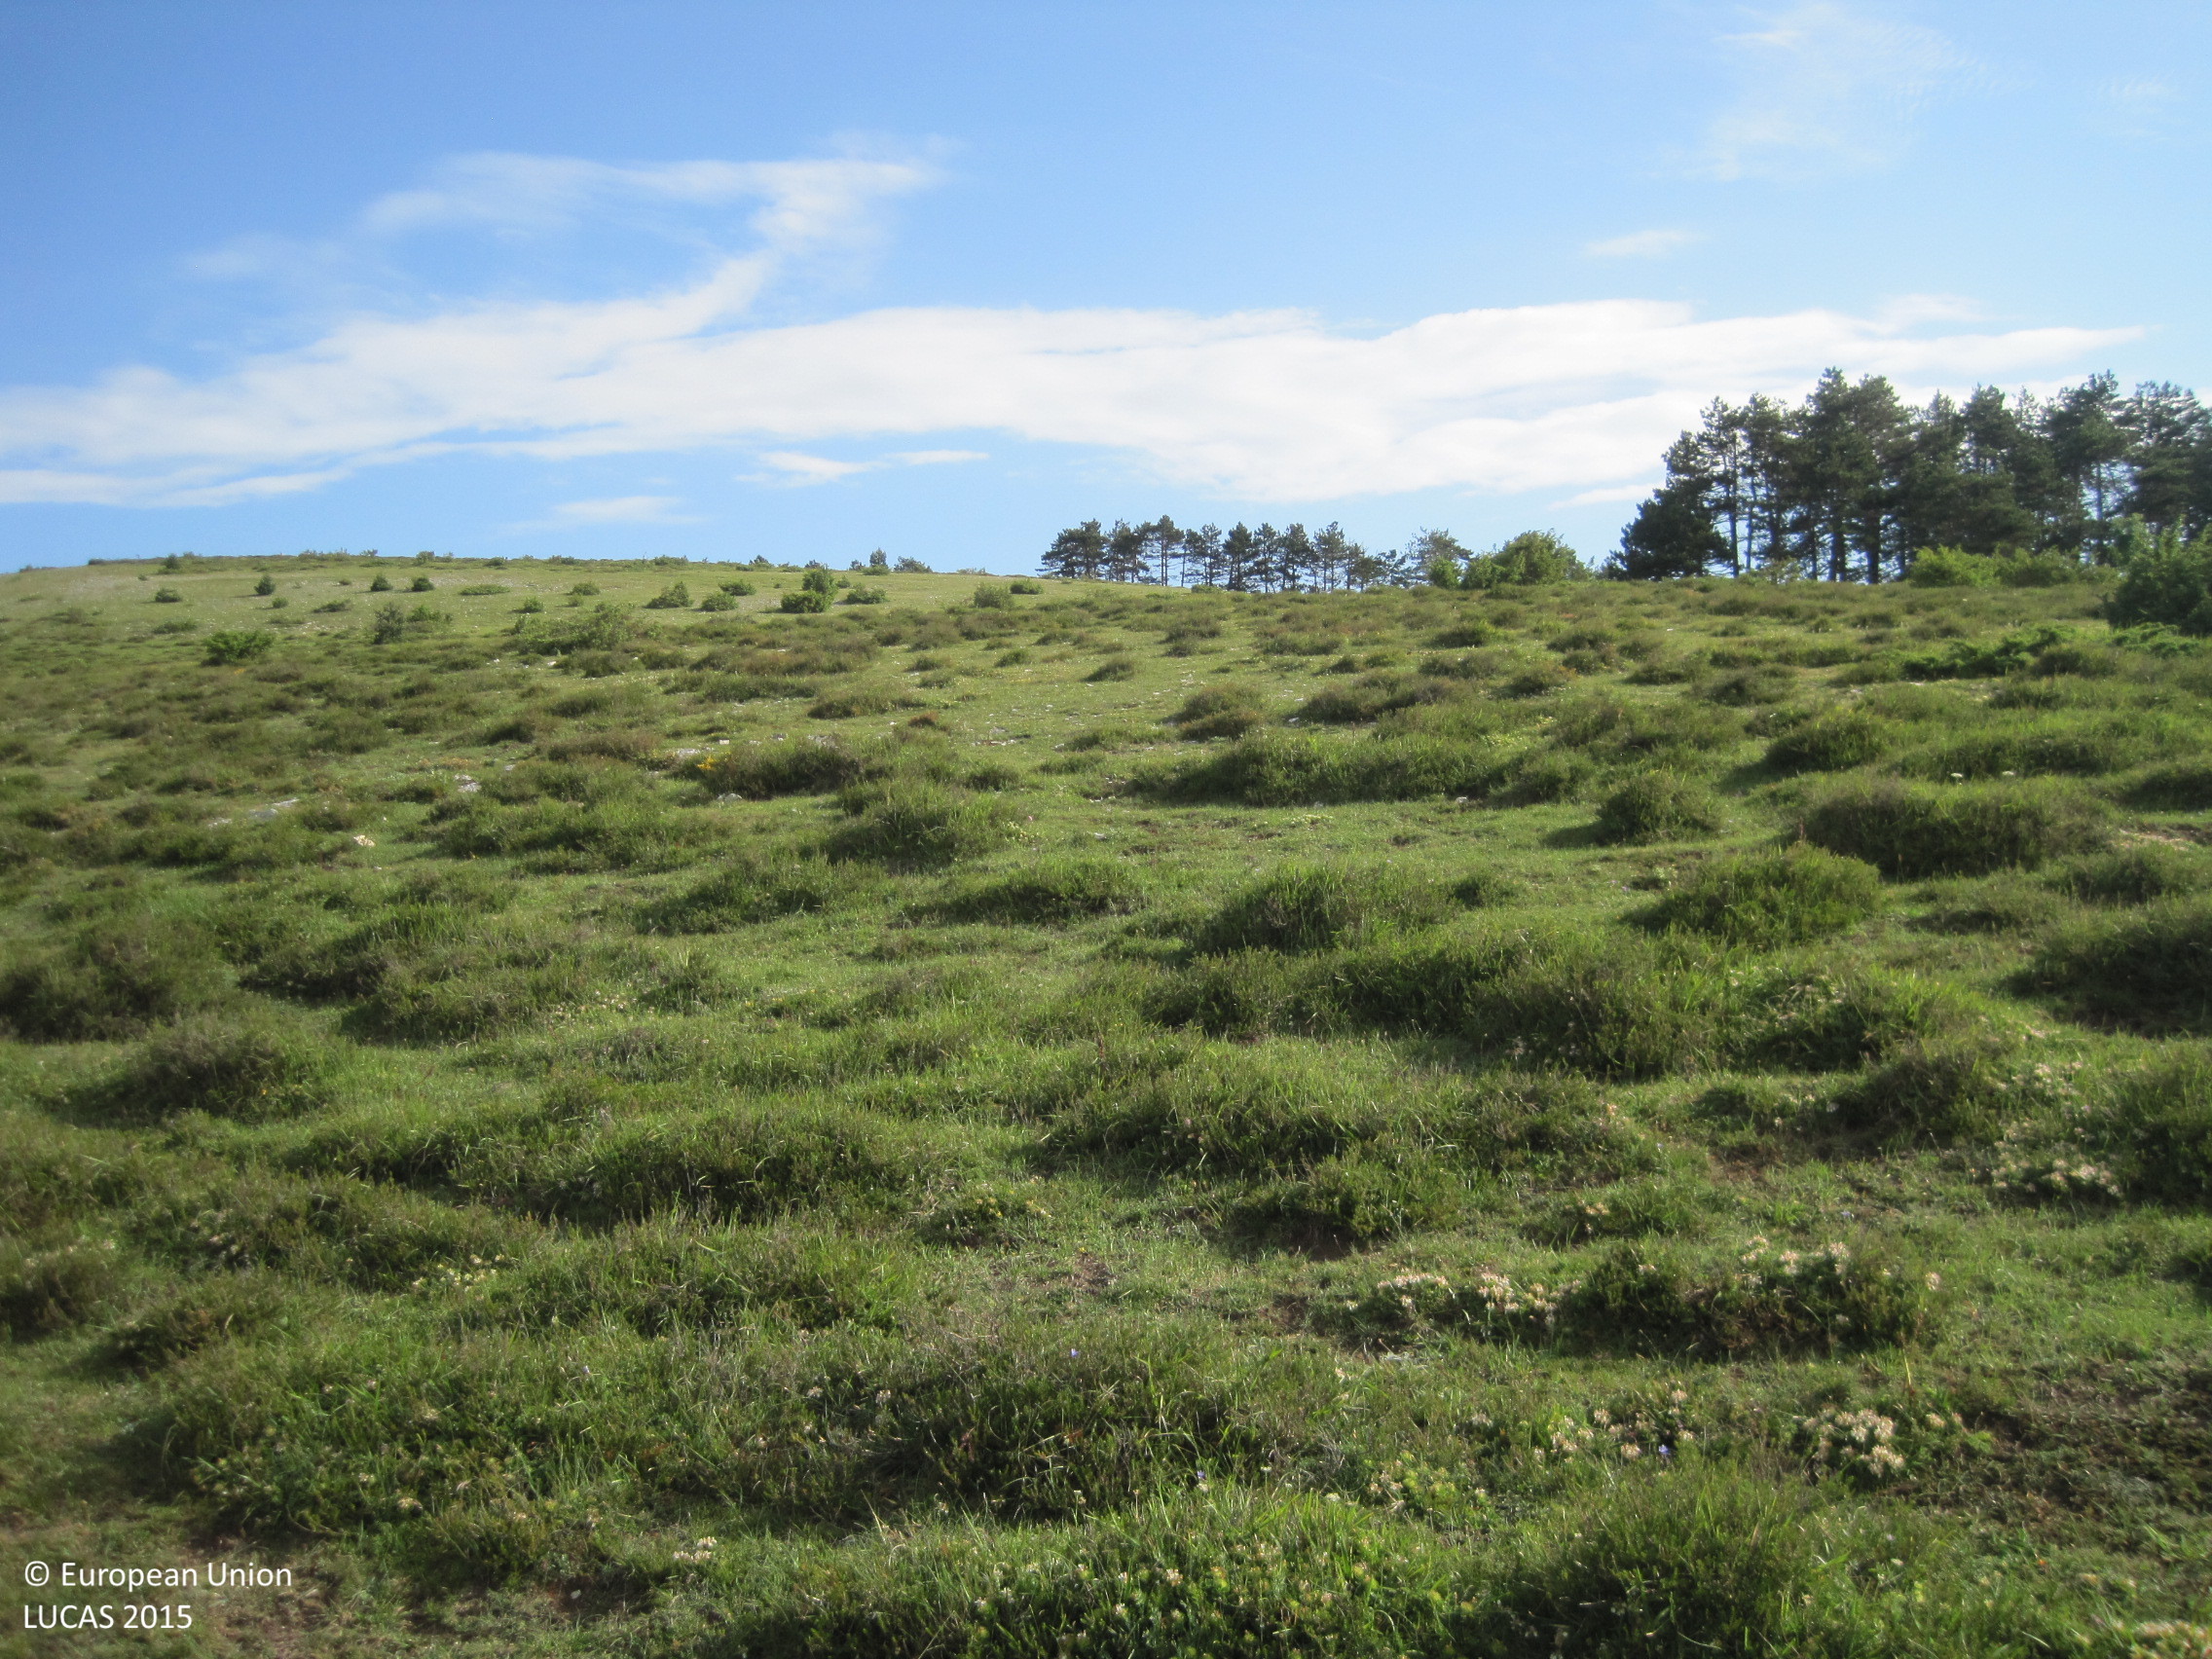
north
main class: Grassland
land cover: Grassland without tree/shrub cover
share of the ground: > 75 %
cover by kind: herbaceous plants 100 %
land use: Agriculture (excluding fallow land and kitchen gardens)
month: June
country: ES
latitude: 42.9166
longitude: -1.7399
